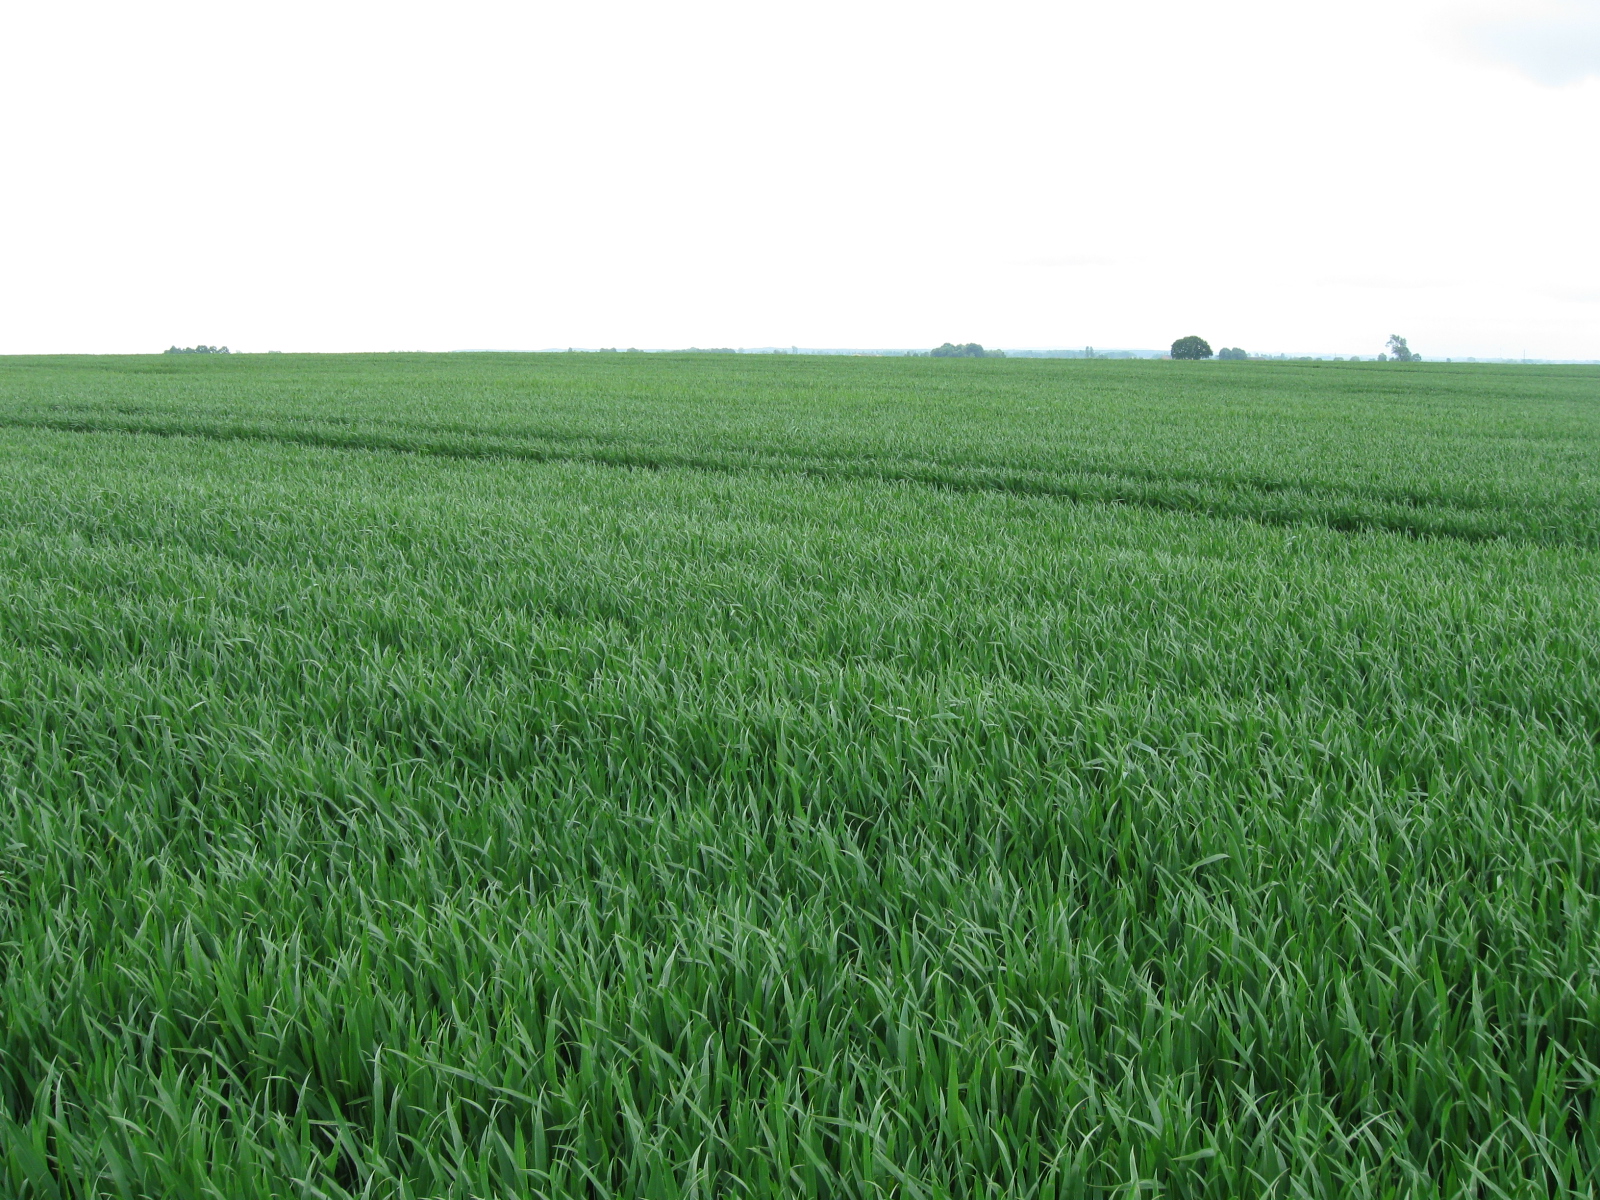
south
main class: Cropland
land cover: Common wheat
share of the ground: > 75 %
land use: Agriculture (excluding fallow land and kitchen gardens)
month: May
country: LT
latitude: 54.6831
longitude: 22.8345
